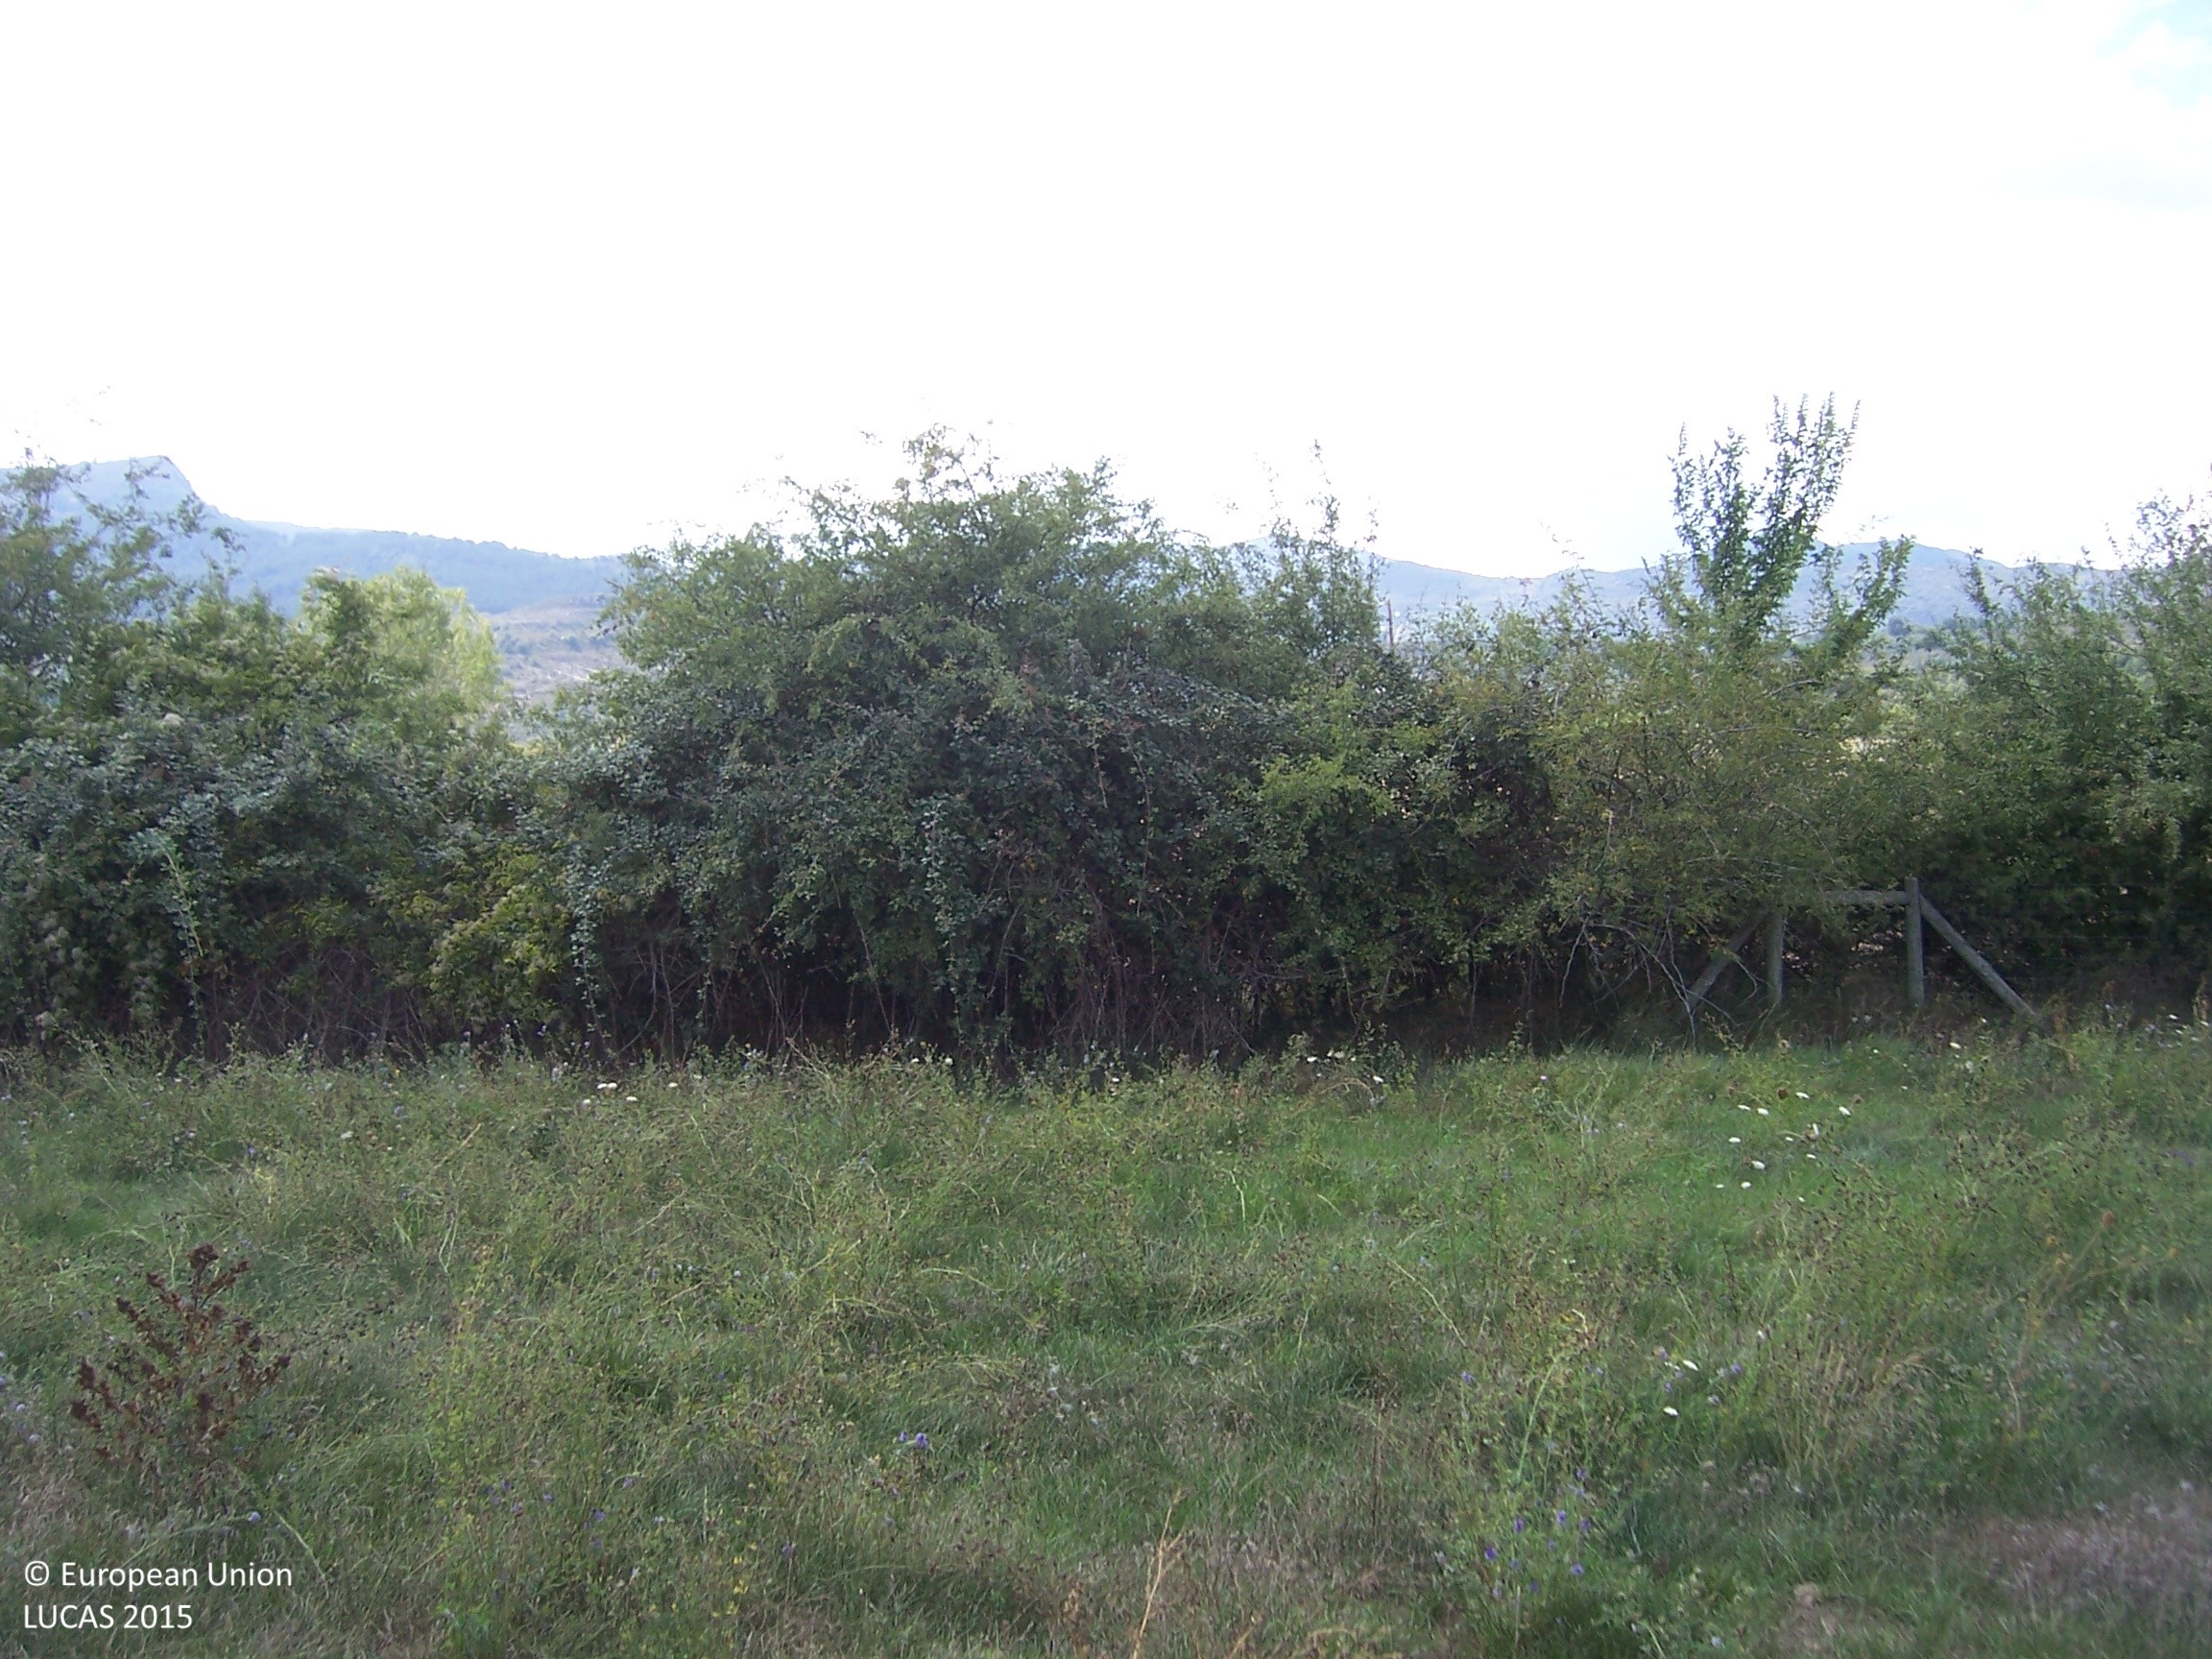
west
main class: Grassland
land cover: Grassland without tree/shrub cover
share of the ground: > 75 %
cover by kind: herbaceous plants 100 %
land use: Agriculture (excluding fallow land and kitchen gardens)
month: August
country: ES
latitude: 42.3077
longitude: 0.0434
